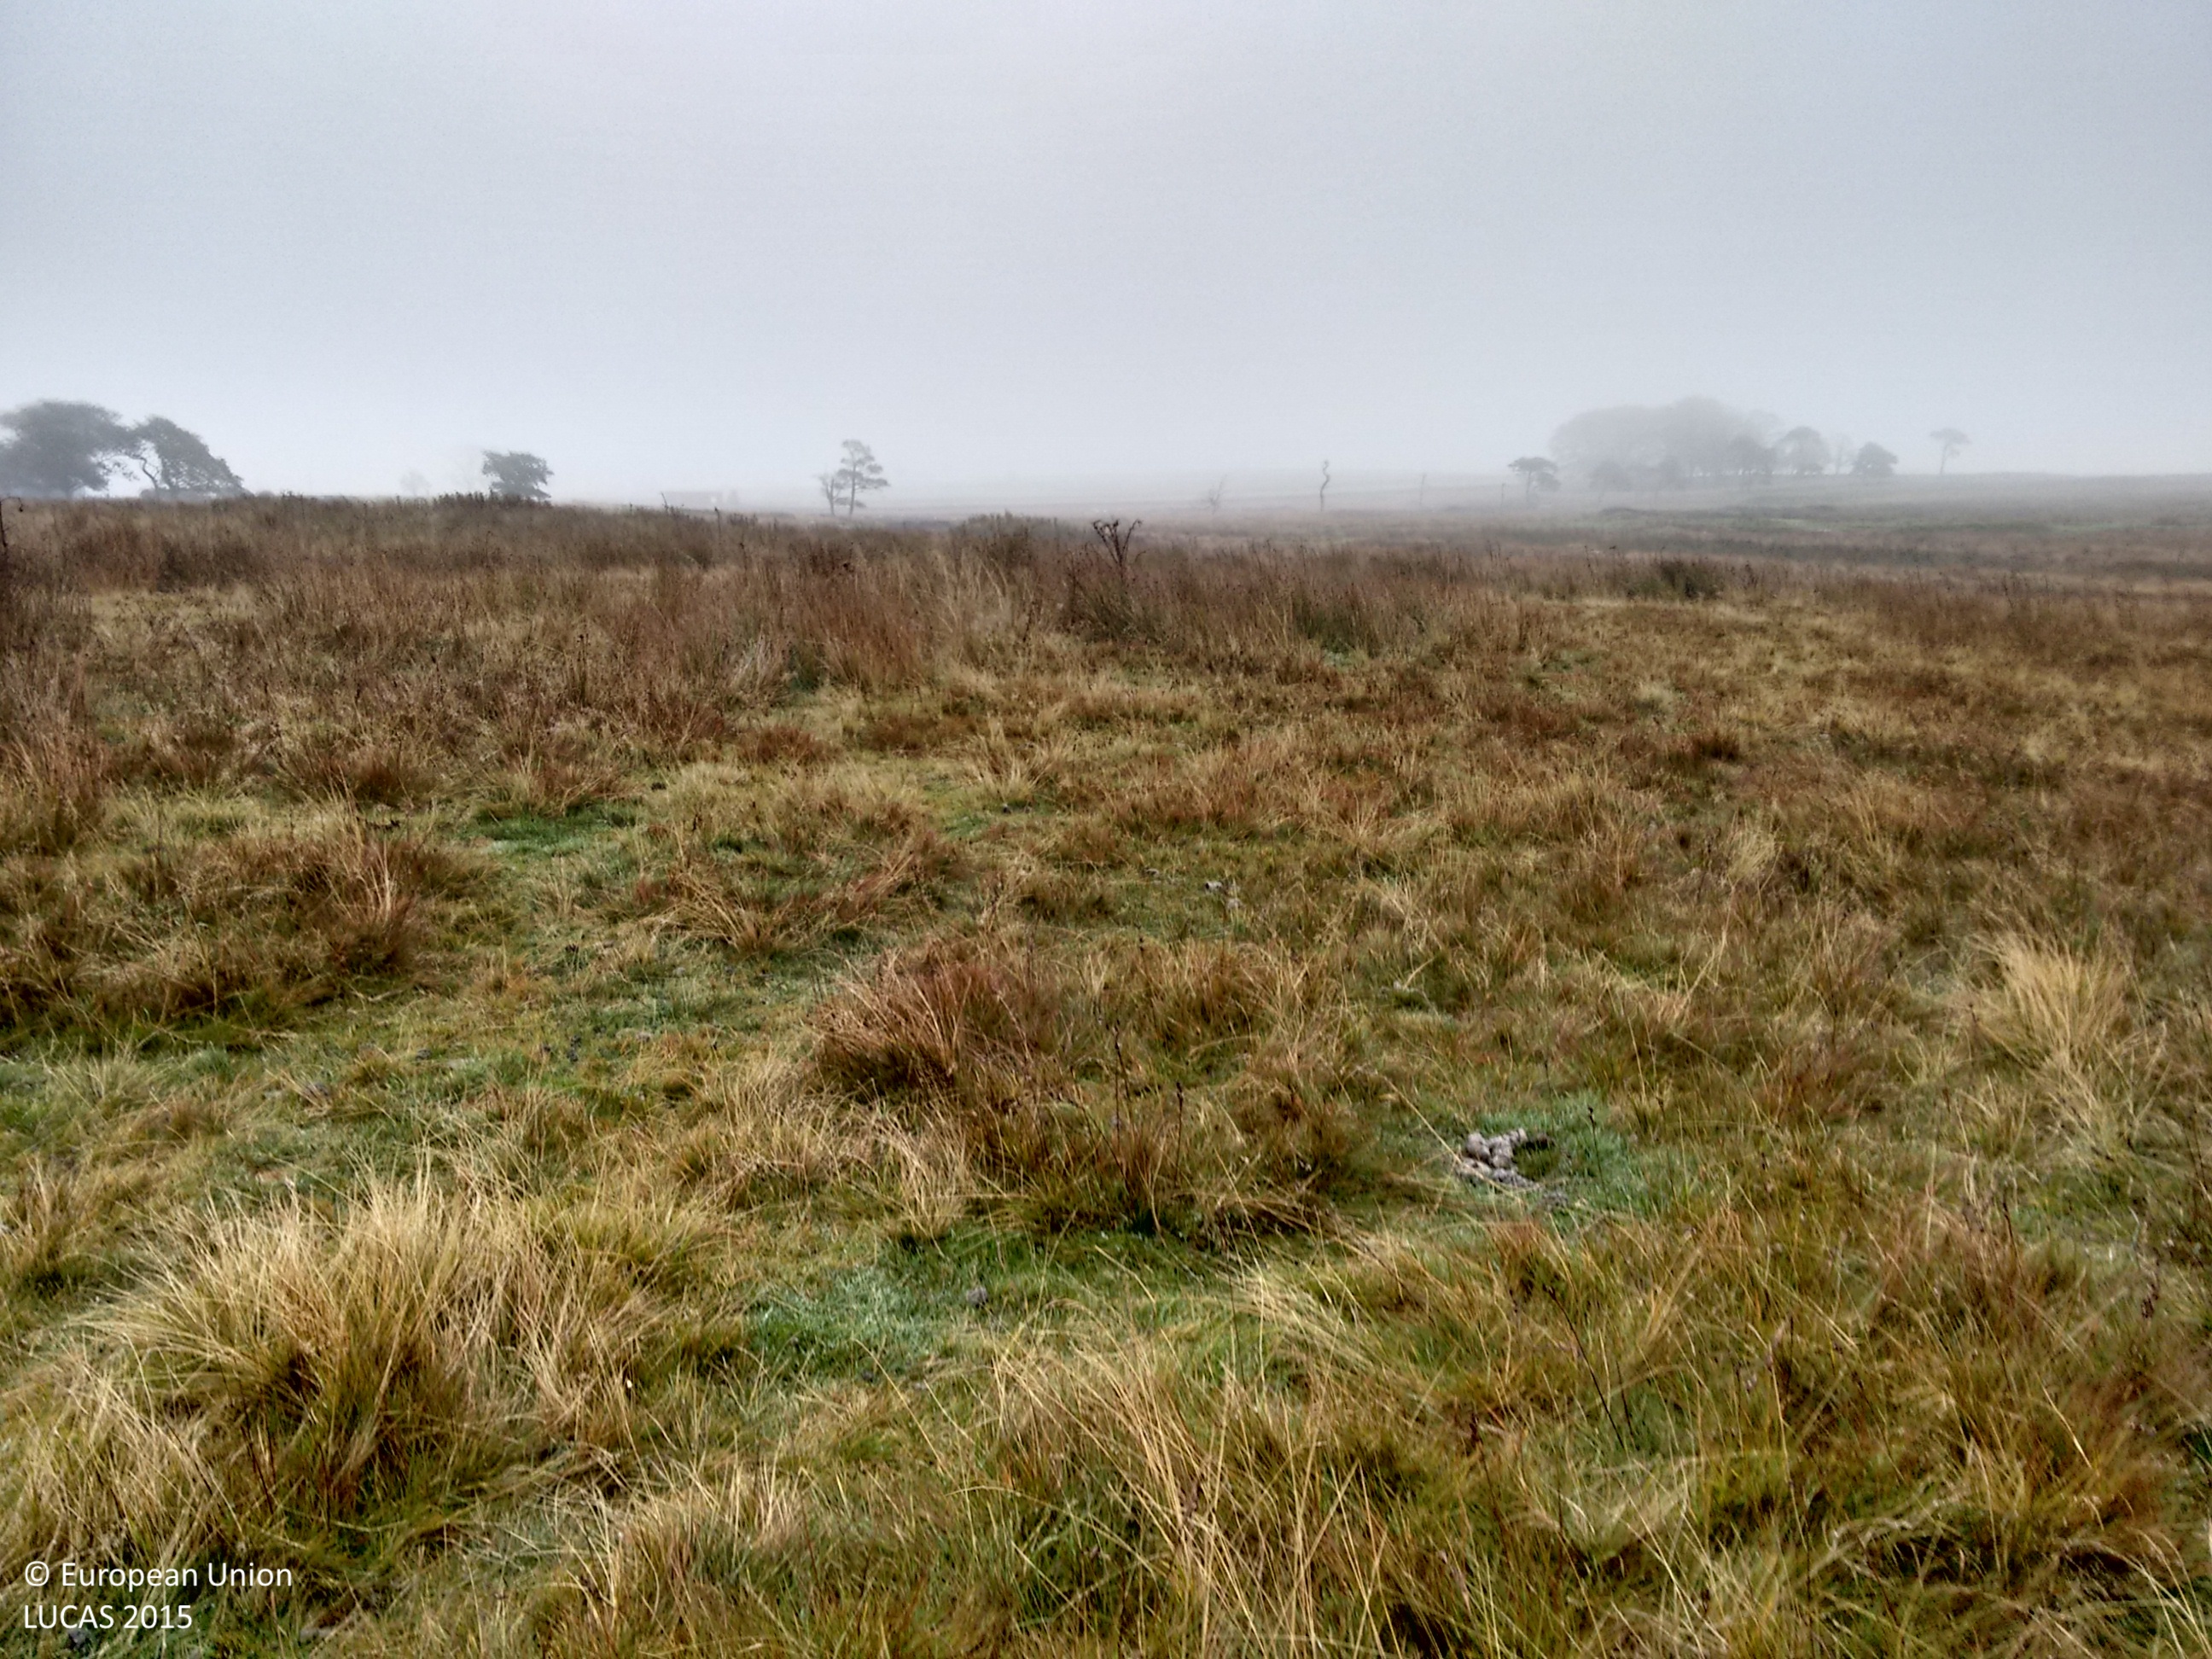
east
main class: Grassland
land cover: Grassland without tree/shrub cover
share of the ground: > 75 %
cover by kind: herbaceous plants 100 %
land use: Agriculture (excluding fallow land and kitchen gardens)
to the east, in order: Grassland without tree/shrub cover; Tracks; Grassland without tree/shrub cover; Rivers and streams; Grass margins; Fences; Grassland without tree/shrub cover
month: October
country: GB
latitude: 54.5274
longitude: -2.0313
